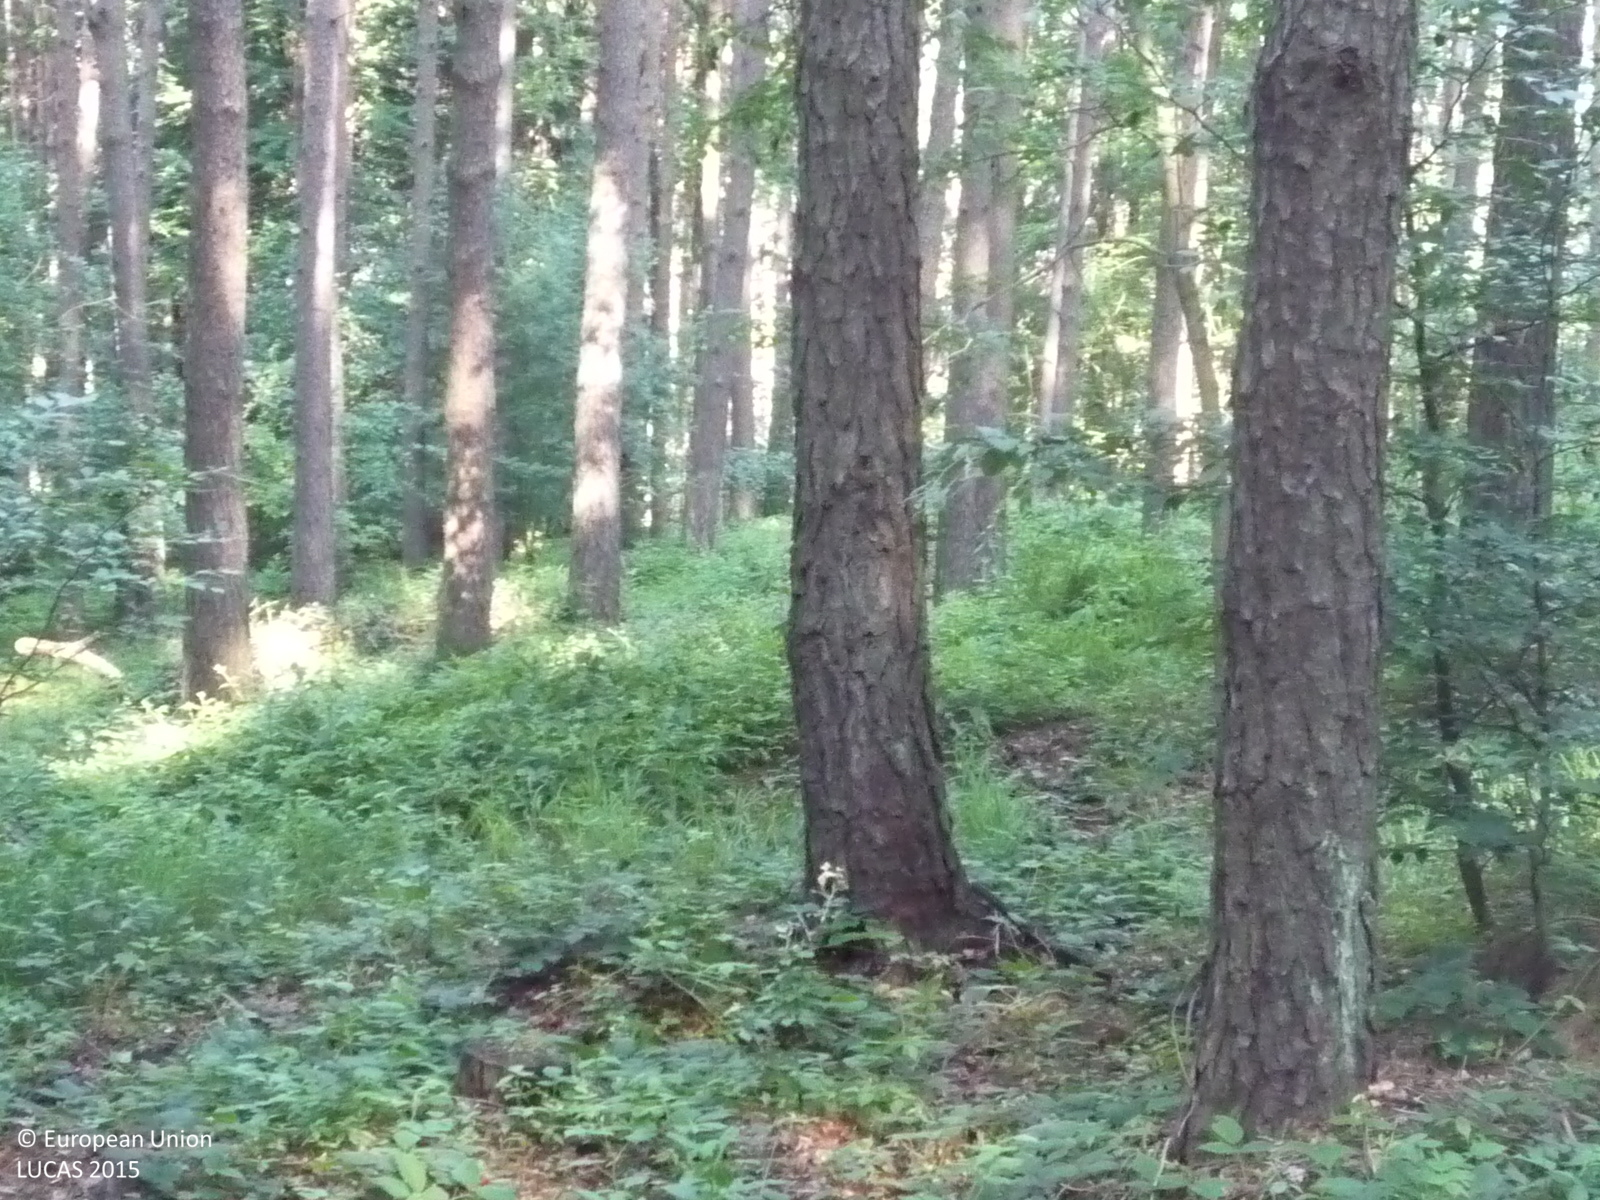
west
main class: Woodland
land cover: Other mixed woodland
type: hemiboreal forest and nemoral coniferous forest and mixed broadleaved-coniferous forest
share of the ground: > 75 %
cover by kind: coniferous forest trees 55 %, broadleaved forest trees 20 %, shrubs 15 %, unconsolidated bare surface 10 %
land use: Forestry
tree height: > 5 m
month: June
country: CZ
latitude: 49.8824
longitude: 15.6408
